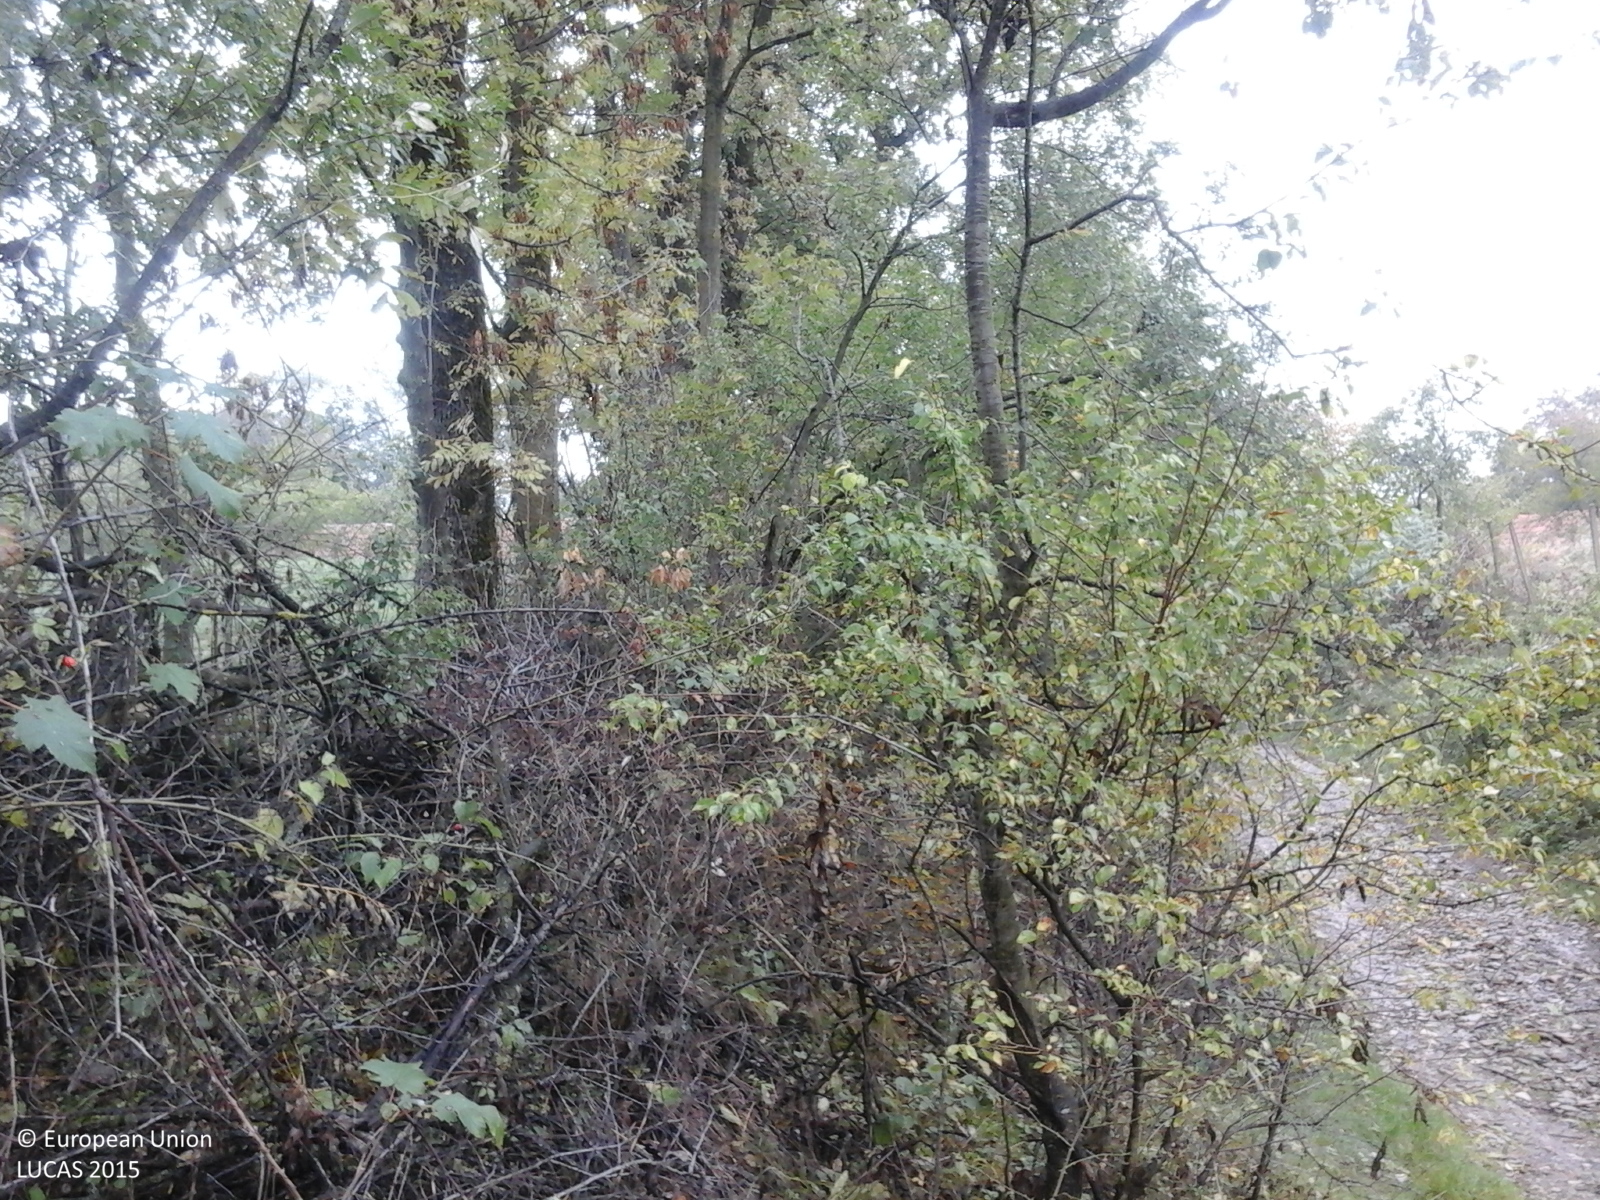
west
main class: Grassland
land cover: Grassland with sparse tree/shrub cover
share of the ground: > 75 %
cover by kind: herbaceous plants 95 %, broadleaved forest trees 5 %
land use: Agriculture (excluding fallow land and kitchen gardens)
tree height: > 5 m
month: October
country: RO
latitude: 45.7209
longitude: 24.9032
